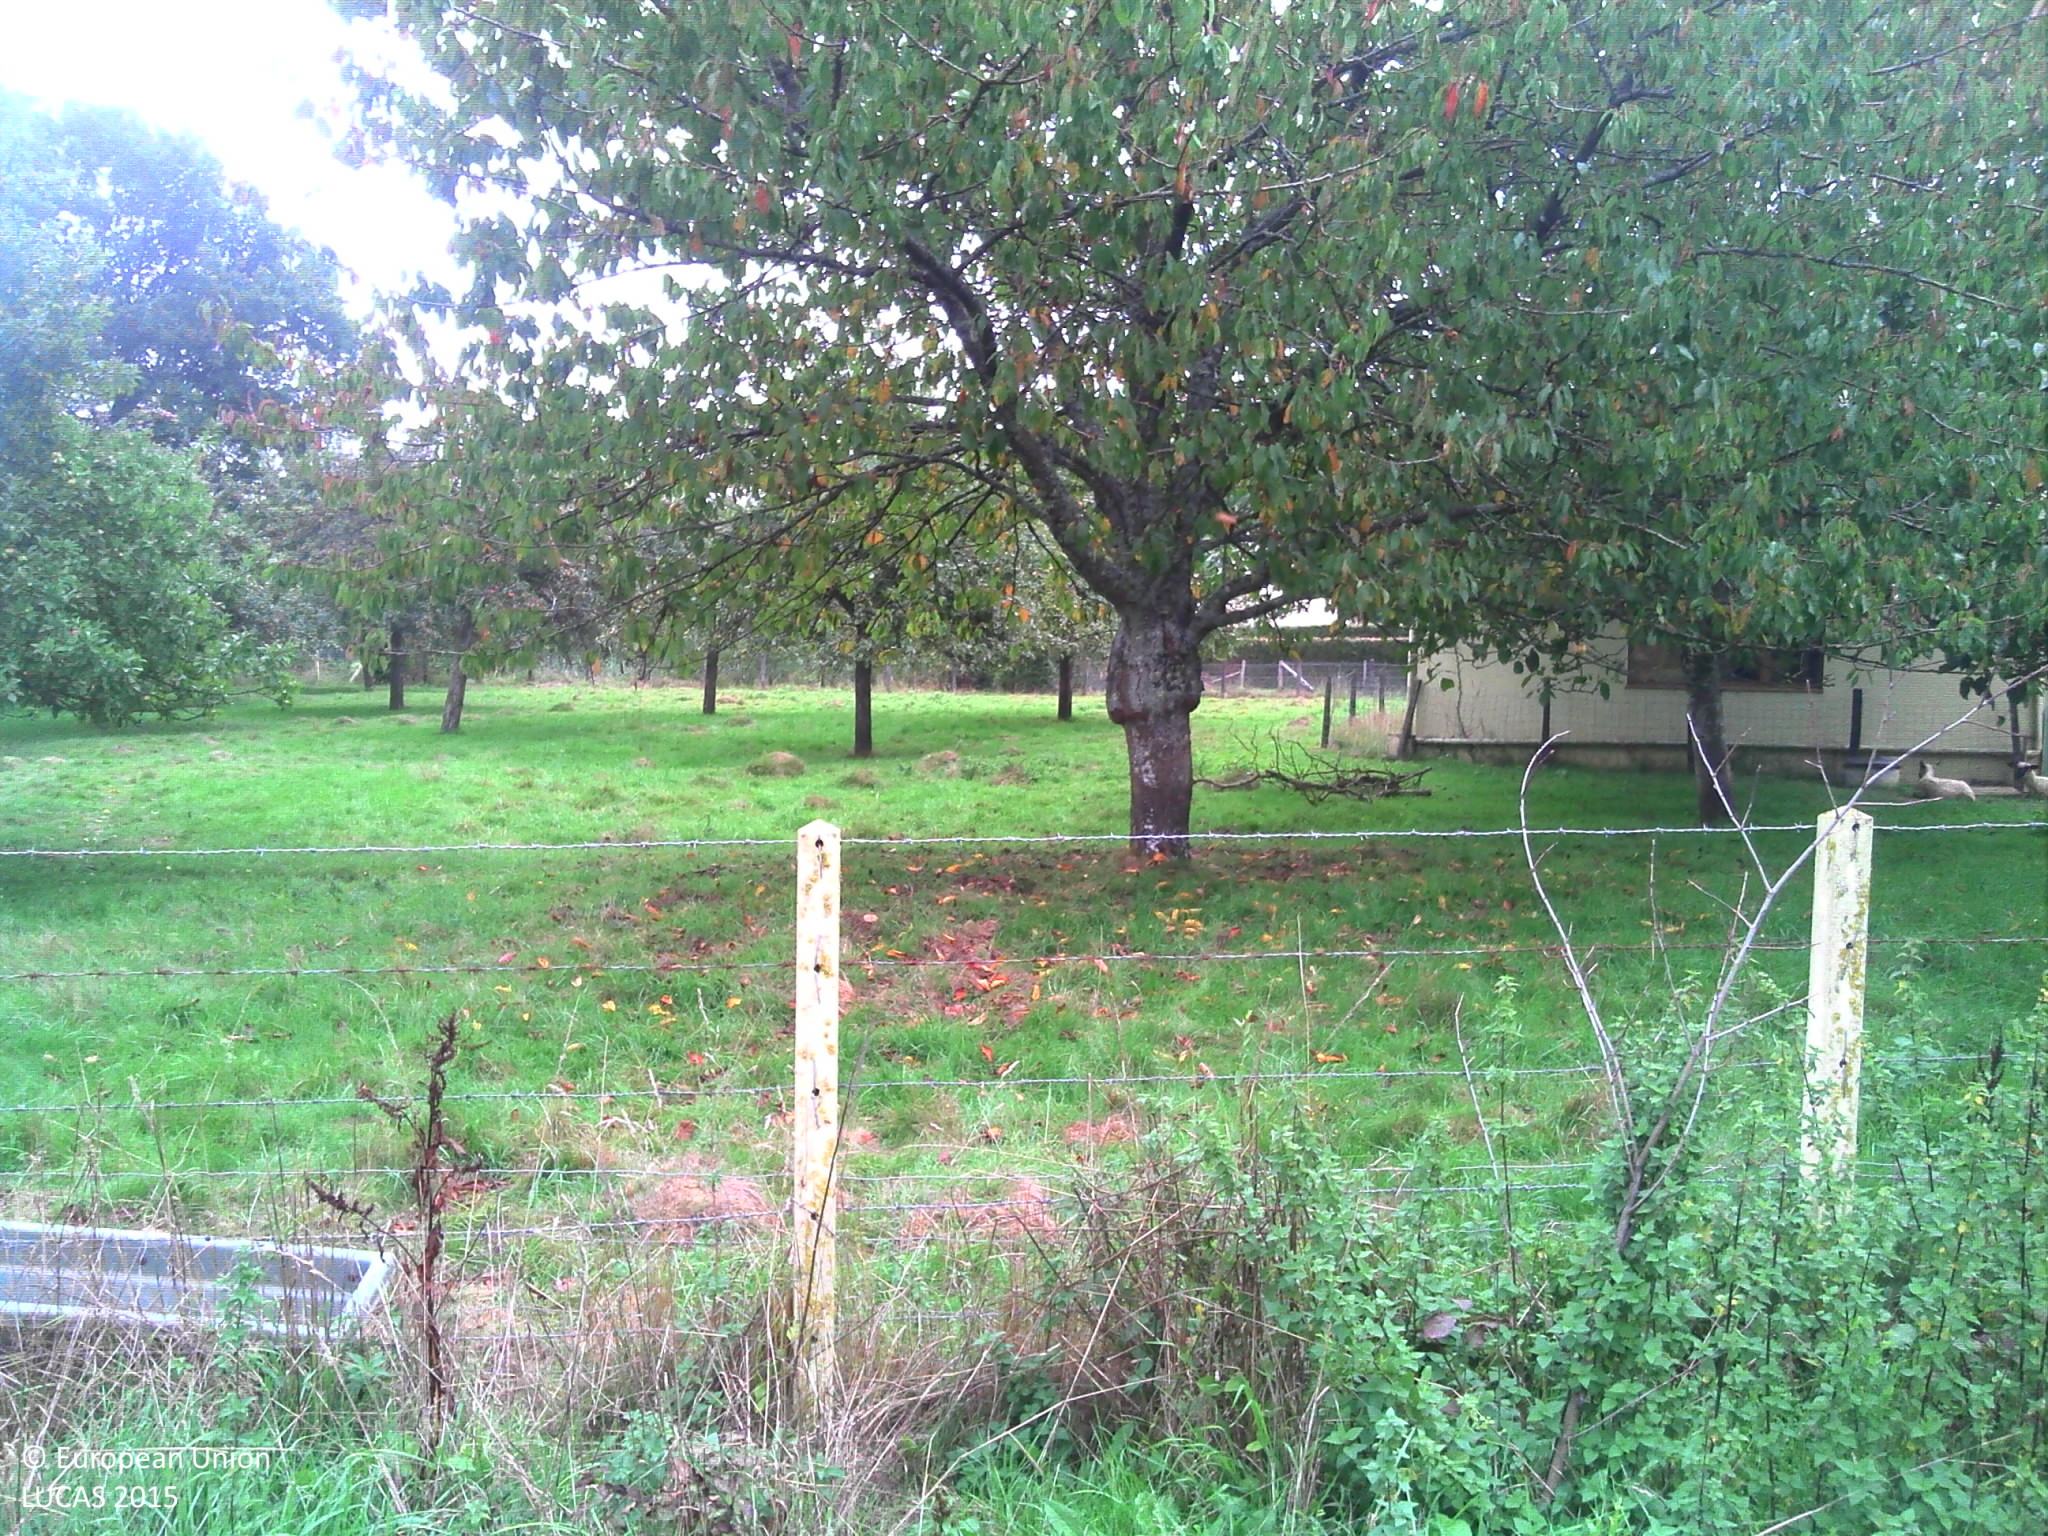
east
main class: Grassland
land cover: Grassland without tree/shrub cover
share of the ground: > 75 %
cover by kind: herbaceous plants 100 %
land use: Residential
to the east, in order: Grassland without tree/shrub cover; Fences; Apple fruit; Electric lines; Apple fruit; Artificial constructions in urban areas; Broadleaved woodland; Ditches and canals; Grass margins; Paved roads, cycling and walking lanes
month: September
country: FR
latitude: 48.5606
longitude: 0.7771
